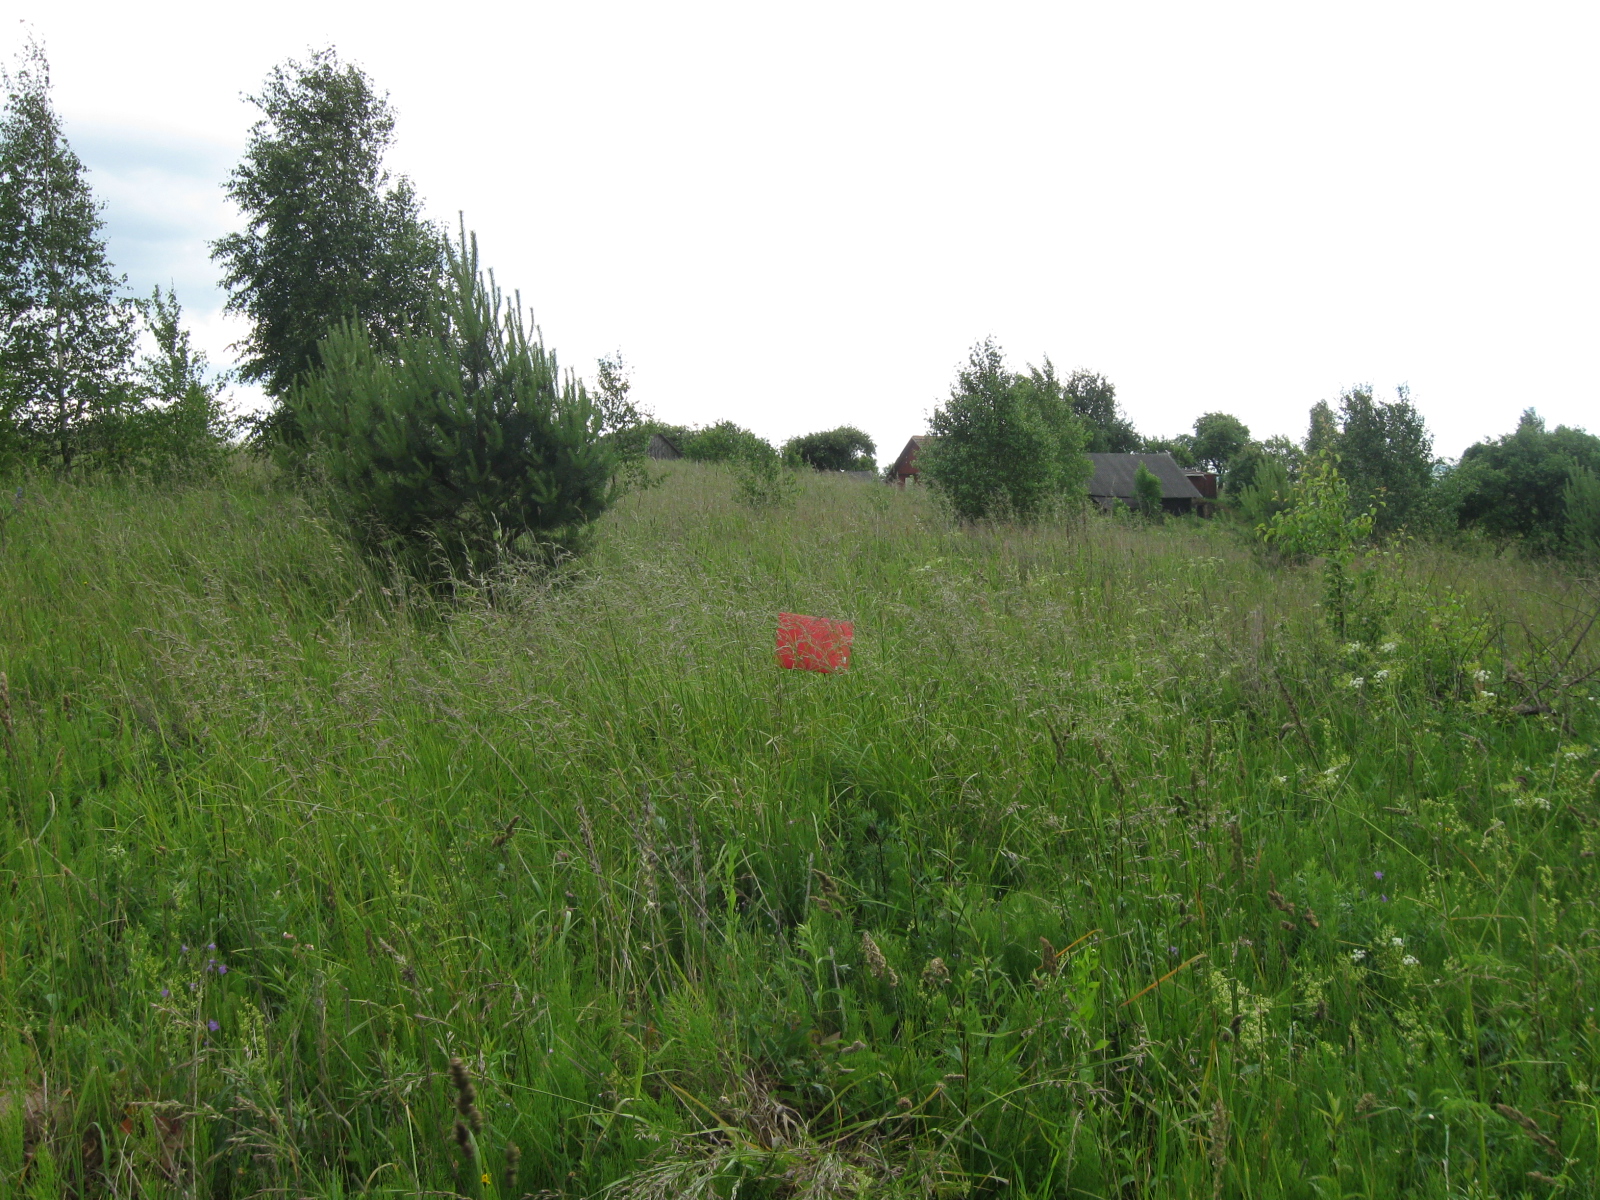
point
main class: Grassland
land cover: Grassland with sparse tree/shrub cover
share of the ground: > 75 %
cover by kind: herbaceous plants 90 %, broadleaved forest trees 5 %, shrubs 5 %
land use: Agriculture (excluding fallow land and kitchen gardens)
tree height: < 5 m
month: June
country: LT
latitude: 54.5638
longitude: 24.4064
